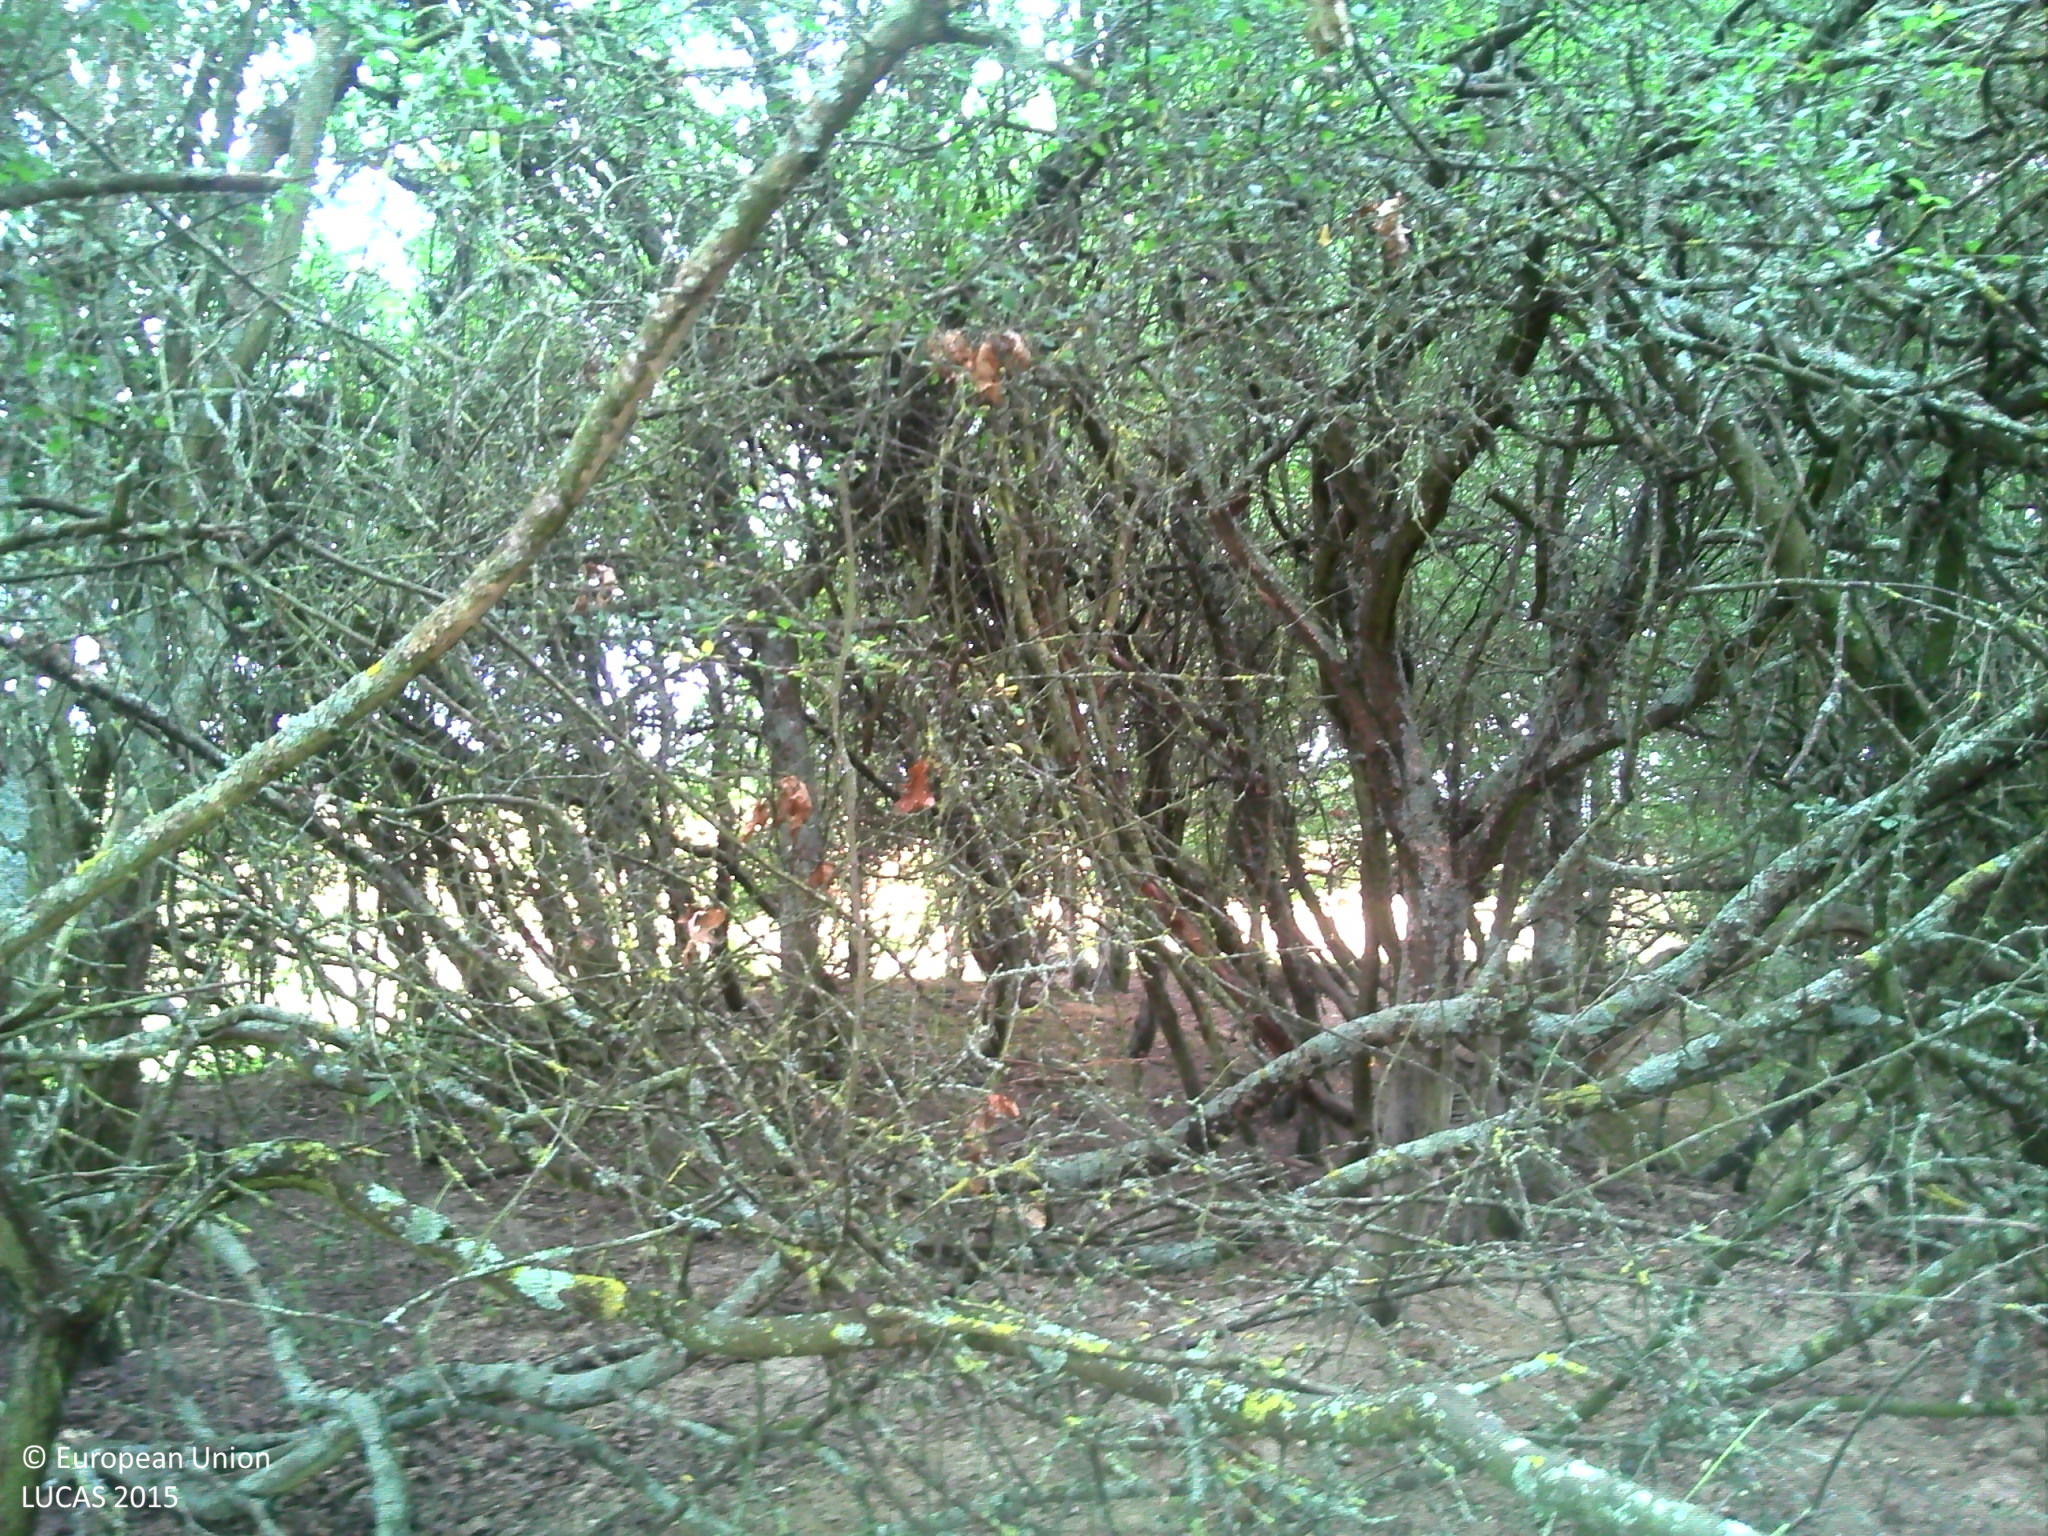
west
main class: Woodland
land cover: Broadleaved woodland
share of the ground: > 75 %
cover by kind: broadleaved forest trees 100 %
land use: Agriculture (excluding fallow land and kitchen gardens)
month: June
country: FR
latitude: 47.6102
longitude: 2.5555
